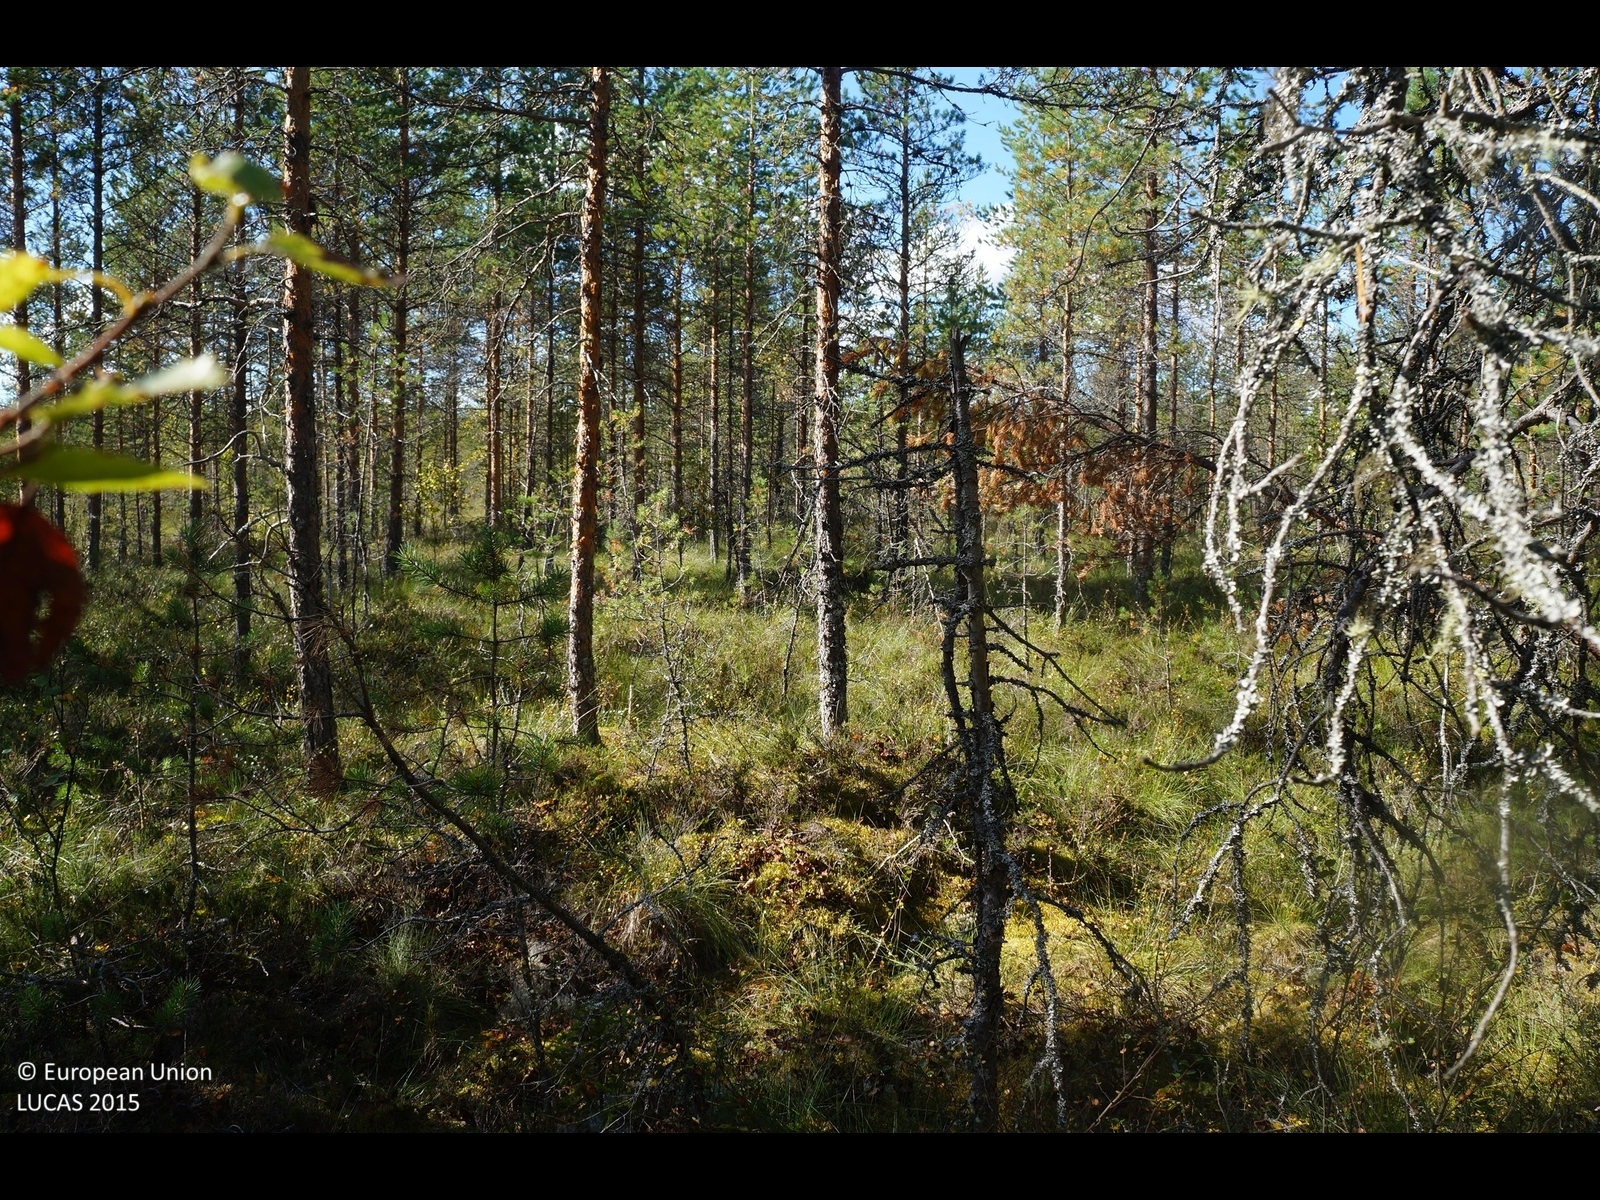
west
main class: Woodland
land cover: Pine dominated coniferous woodland
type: boreal forest
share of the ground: 50 - 75 %
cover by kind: coniferous forest trees 55 %, shrubs 30 %, lichens and mosses 10 %, herbaceous plants 5 %
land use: Forestry
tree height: > 5 m
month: September
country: FI
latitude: 63.9944
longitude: 24.4025
